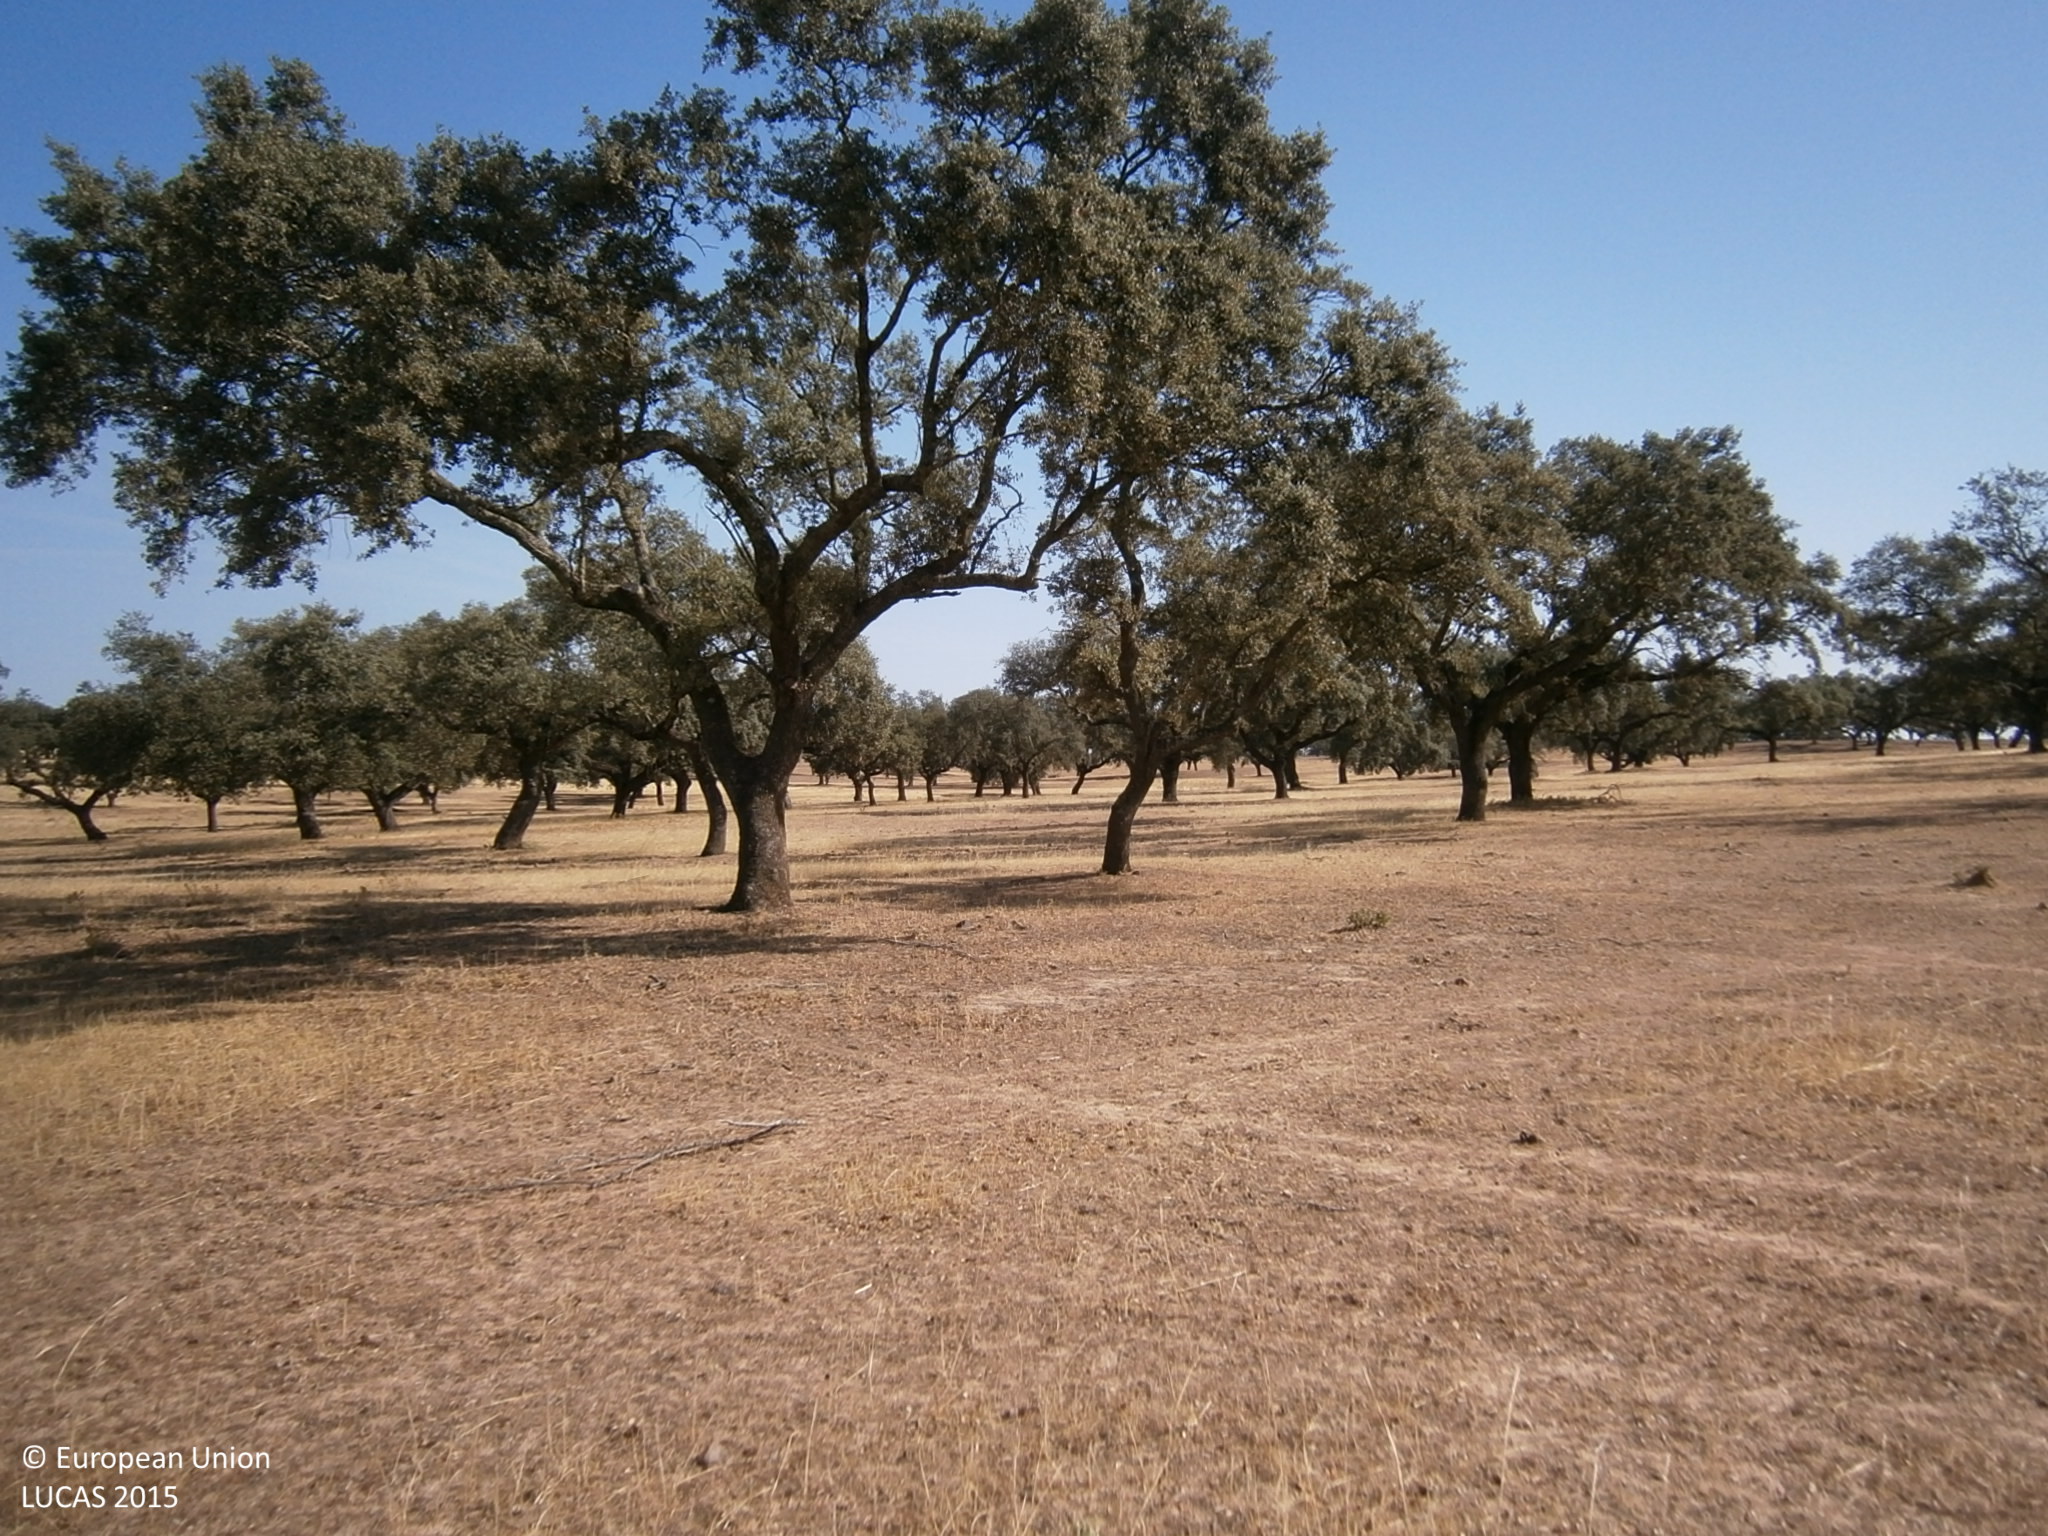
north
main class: Woodland
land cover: Broadleaved woodland
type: broadleaved evergreen forest
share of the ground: 10 - 25 %
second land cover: Spontaneously vegetated surfaces
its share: 50 - 75 %
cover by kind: herbaceous plants 65 %, broadleaved forest trees 25 %, unconsolidated bare surface 10 %
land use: Forestry
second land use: Agriculture (excluding fallow land and kitchen gardens)
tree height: > 5 m
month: July
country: ES
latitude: 39.0389
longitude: -6.7389
